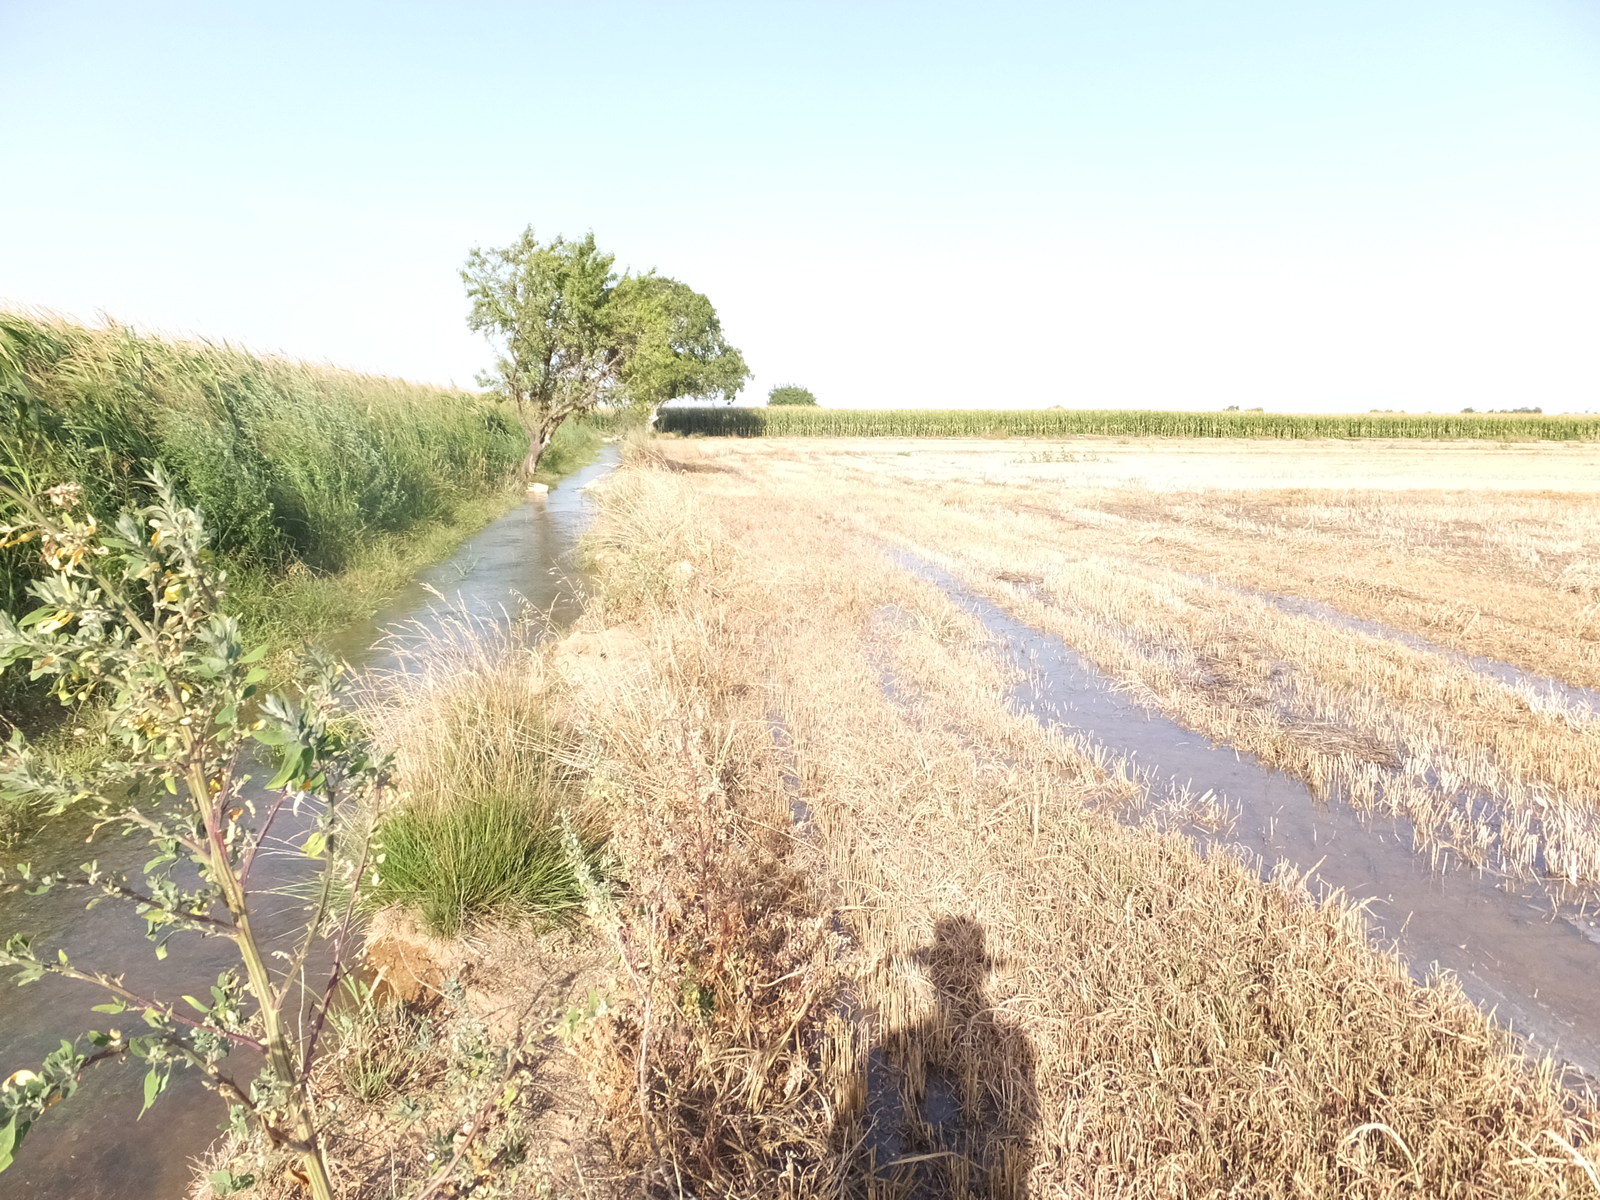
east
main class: Cropland
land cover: Common wheat
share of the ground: < 10 %
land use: Agriculture (excluding fallow land and kitchen gardens)
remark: Harvested field
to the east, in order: Common wheat; Shruby margins
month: August
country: ES
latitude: 41.6307
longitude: 0.3714
